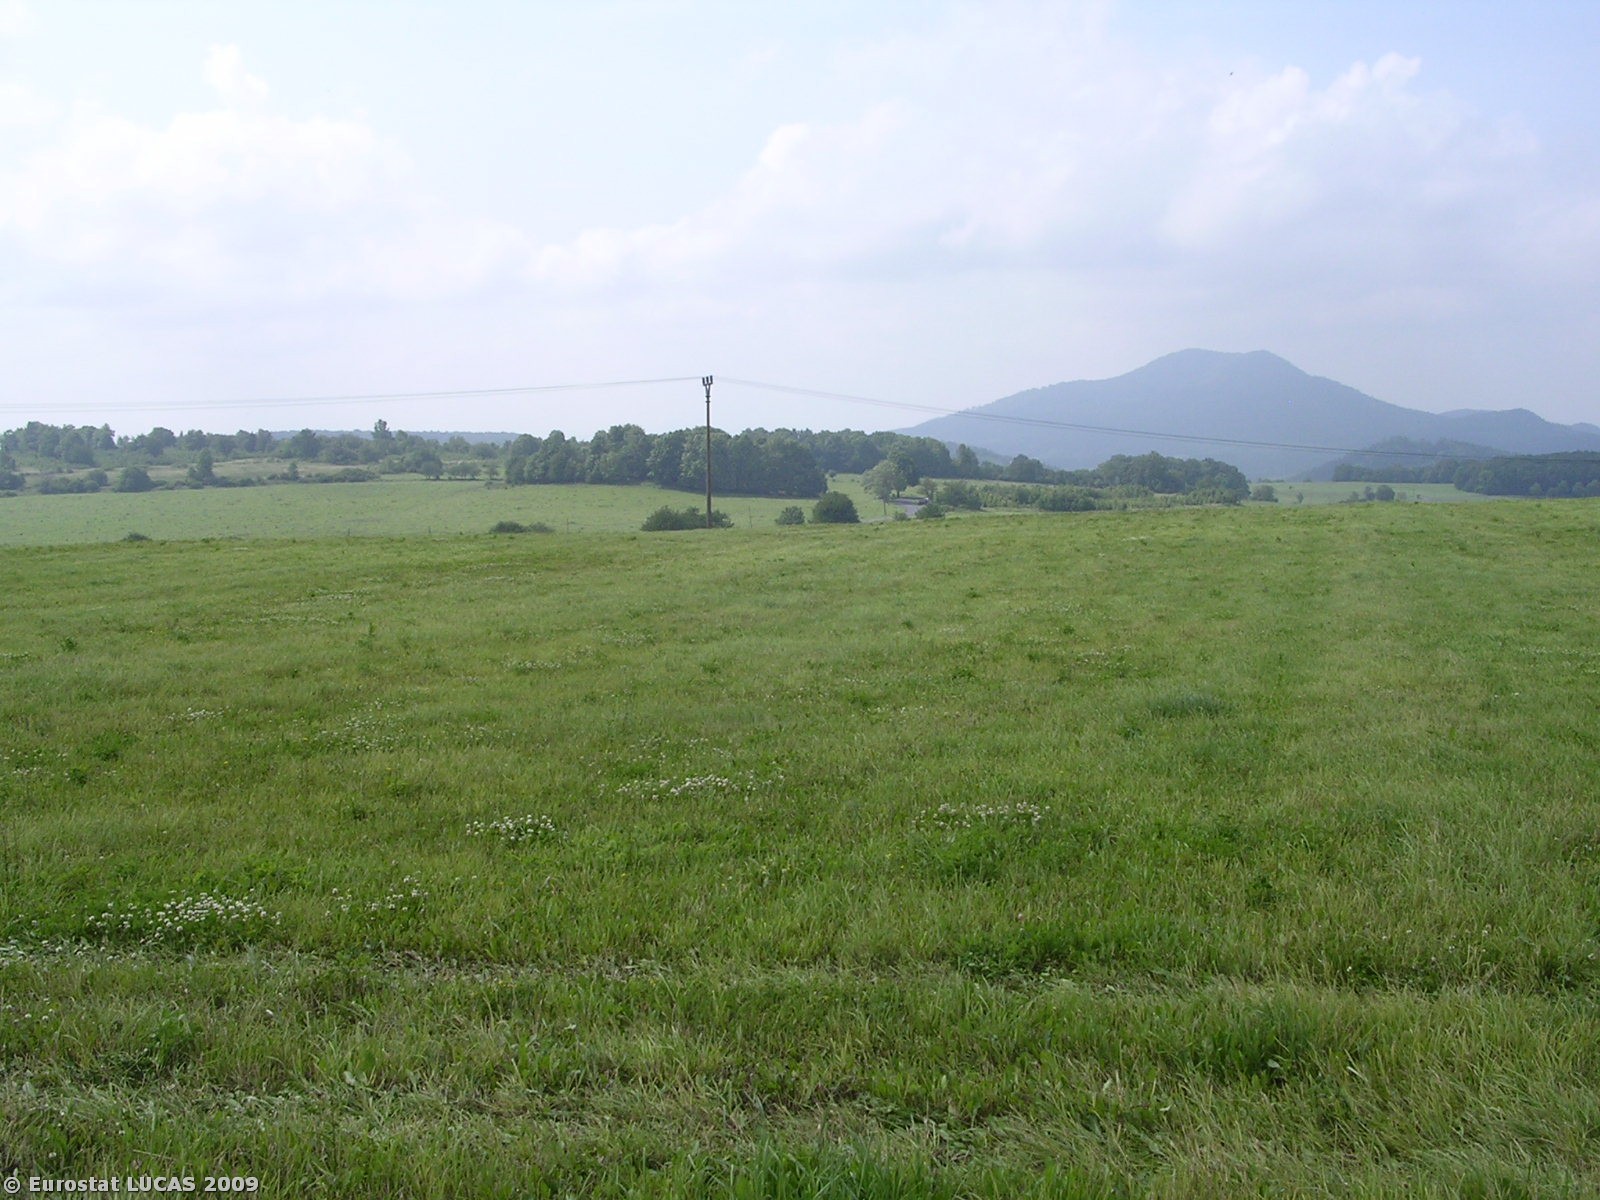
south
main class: Grassland
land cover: Grassland without tree/shrub cover
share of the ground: > 75 %
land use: Agriculture (excluding fallow land and kitchen gardens)
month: June
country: CZ
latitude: 50.6439
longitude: 14.2863
